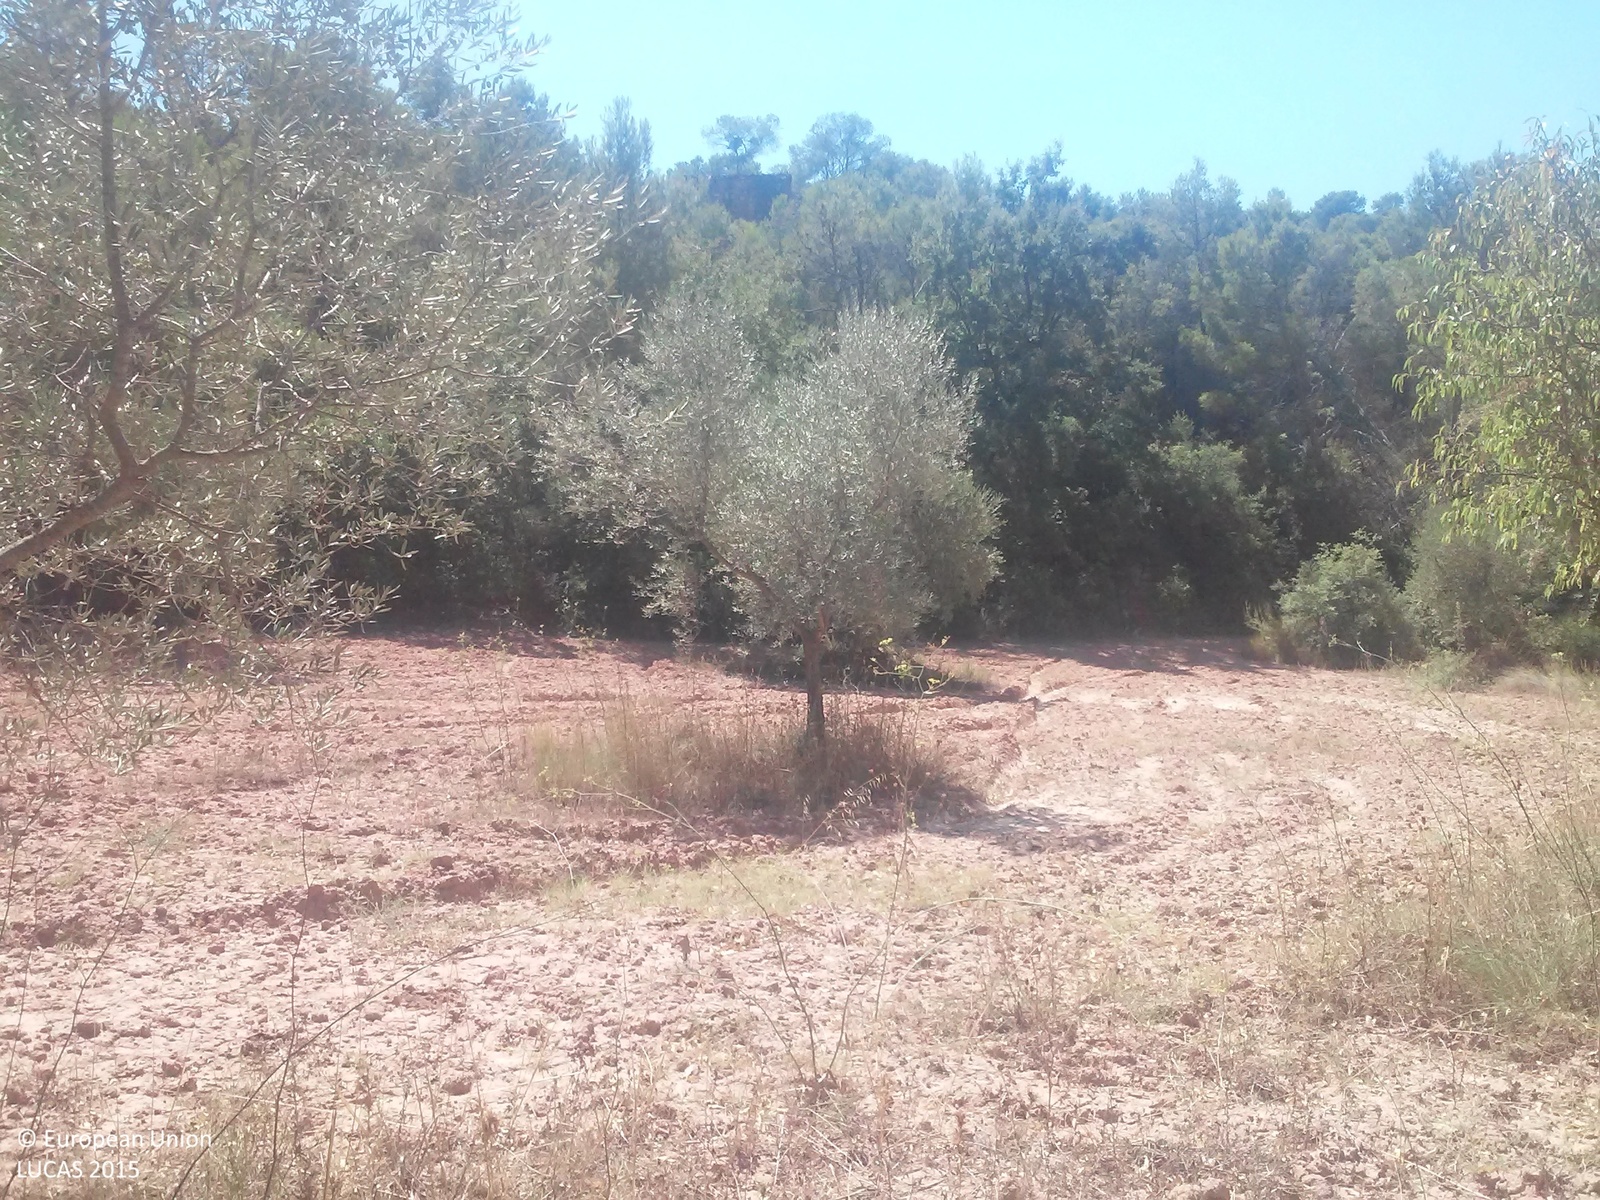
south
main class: Cropland
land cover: Olive groves
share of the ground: < 10 %
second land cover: Nuts trees
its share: < 10 %
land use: Agriculture (excluding fallow land and kitchen gardens)
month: August
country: ES
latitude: 41.3241
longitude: 0.5874
